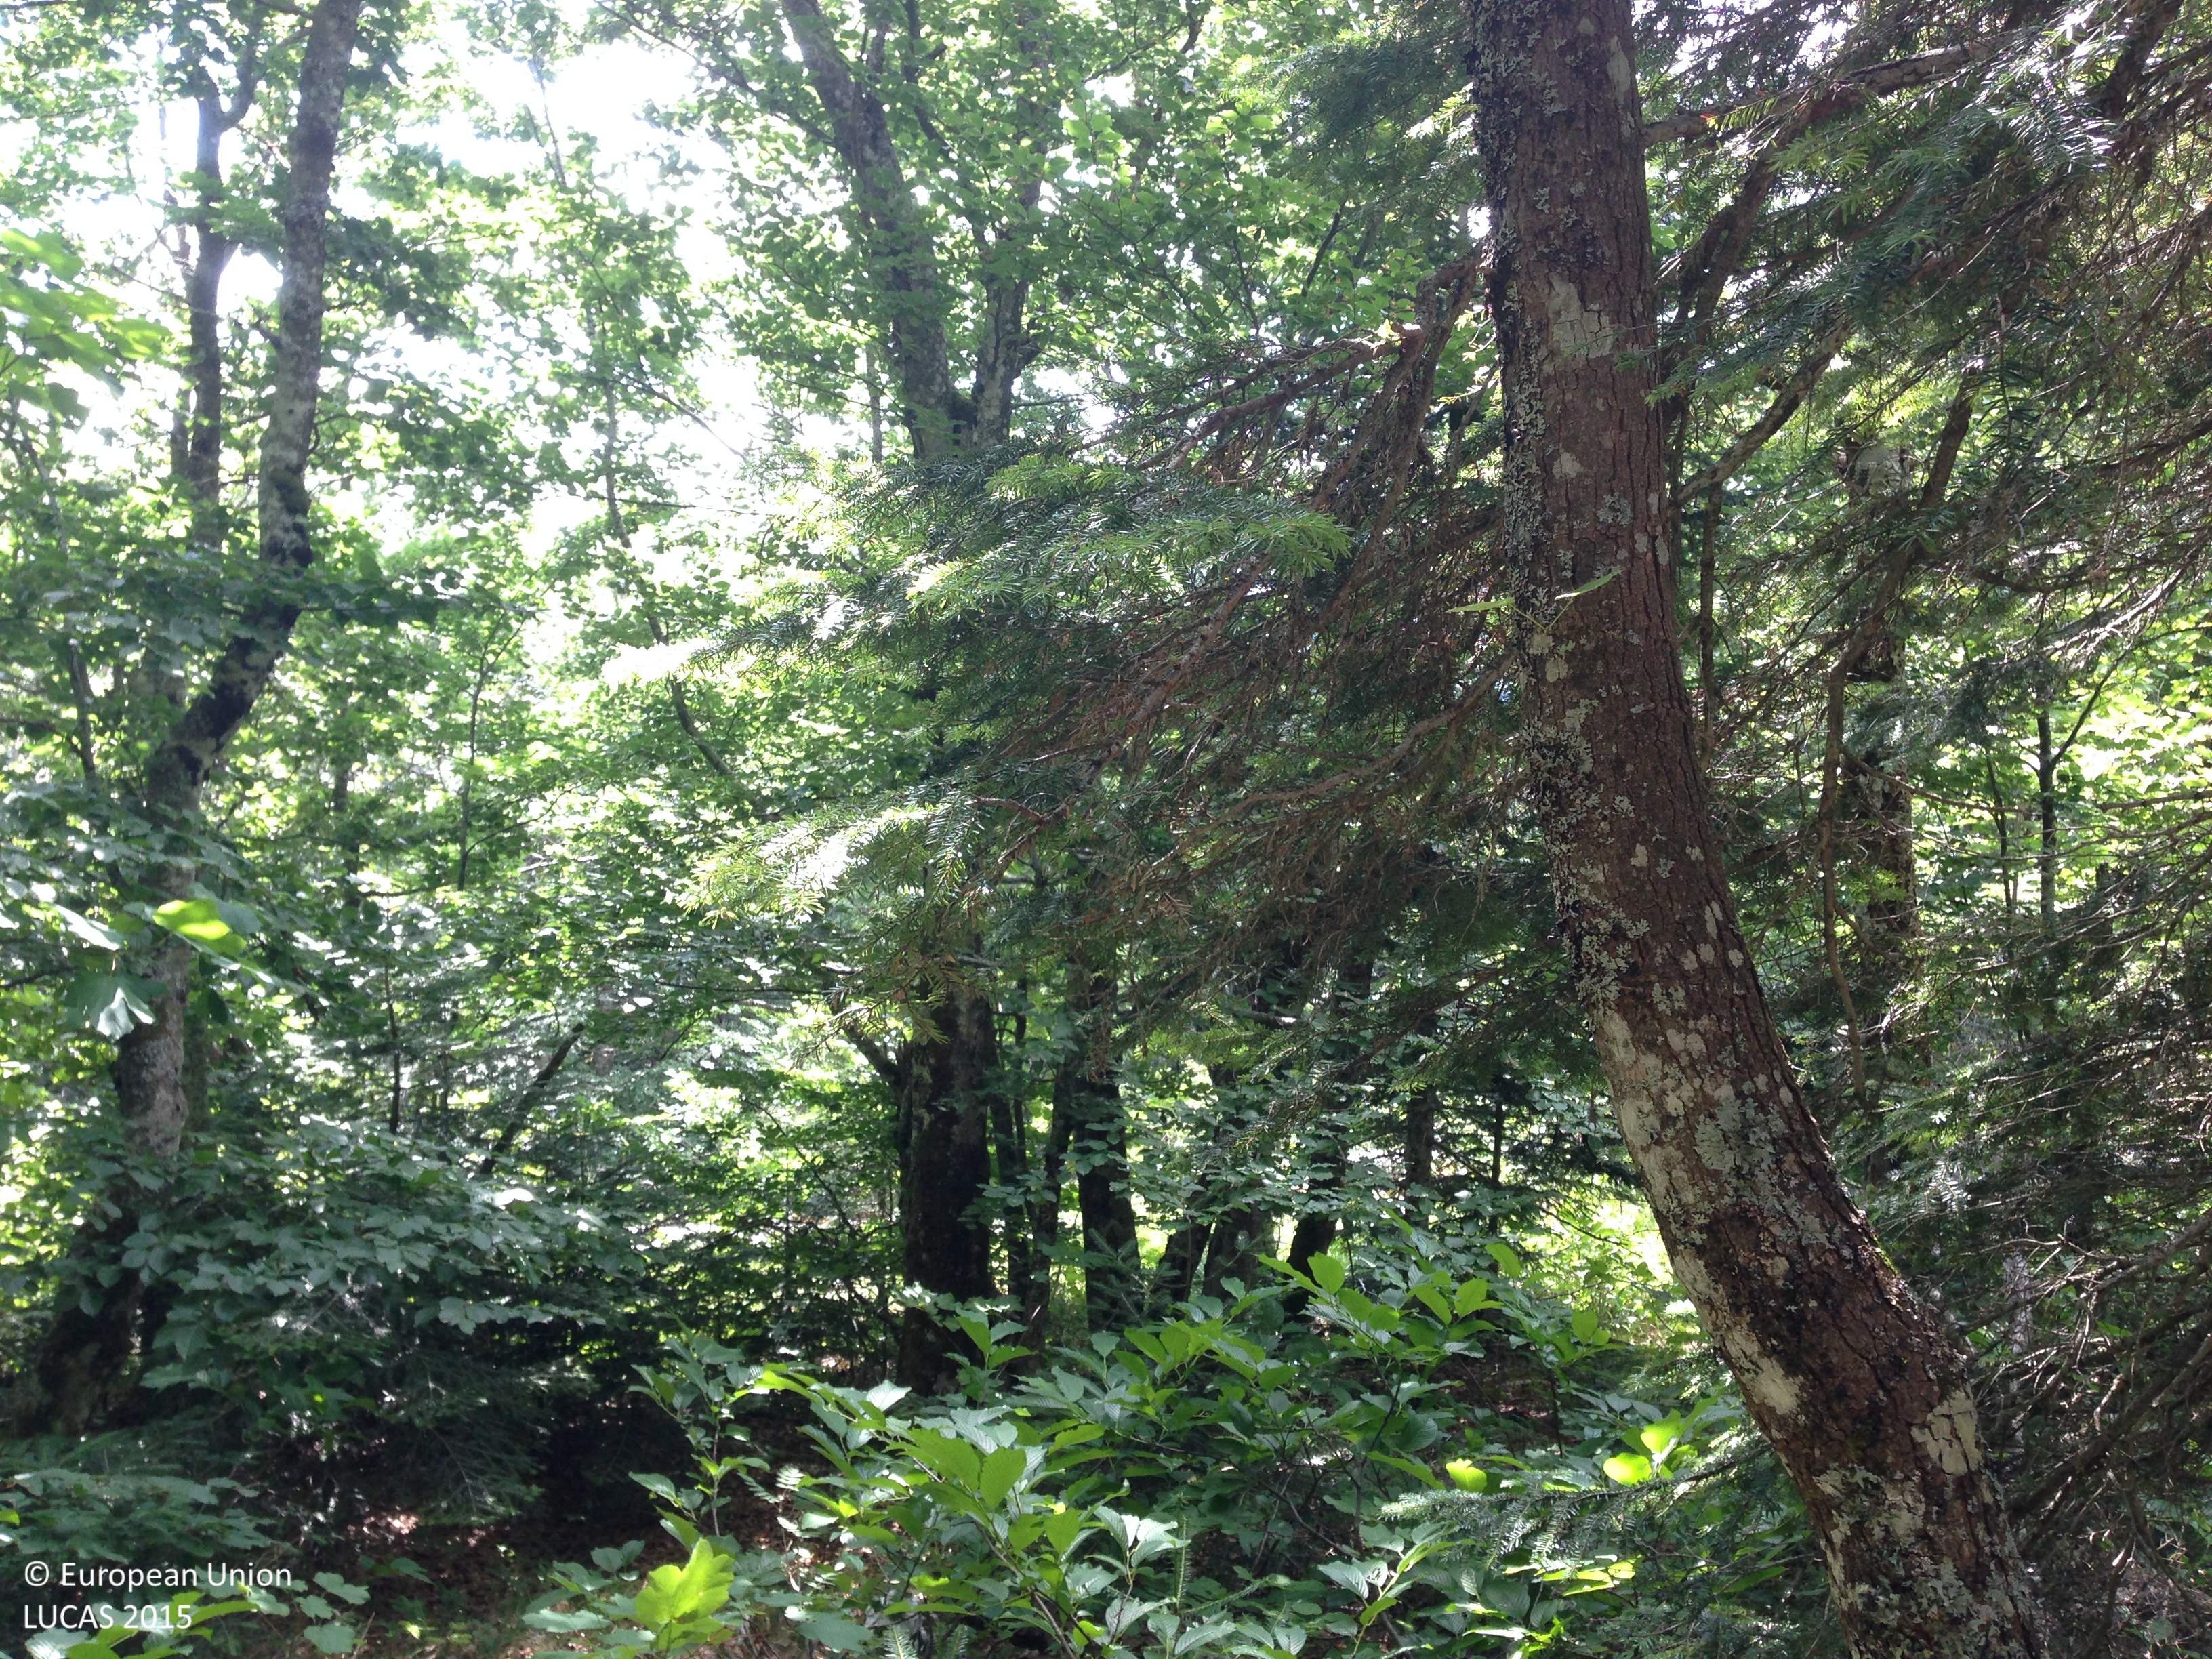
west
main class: Woodland
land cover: Other mixed woodland
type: mountainous beech forest
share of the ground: > 75 %
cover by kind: coniferous forest trees 40 %, broadleaved forest trees 30 %, herbaceous plants 20 %, shrubs 5 %, consolidated bare surface 5 %
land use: Forestry
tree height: > 5 m
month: June
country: HR
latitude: 44.7892
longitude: 15.7202
